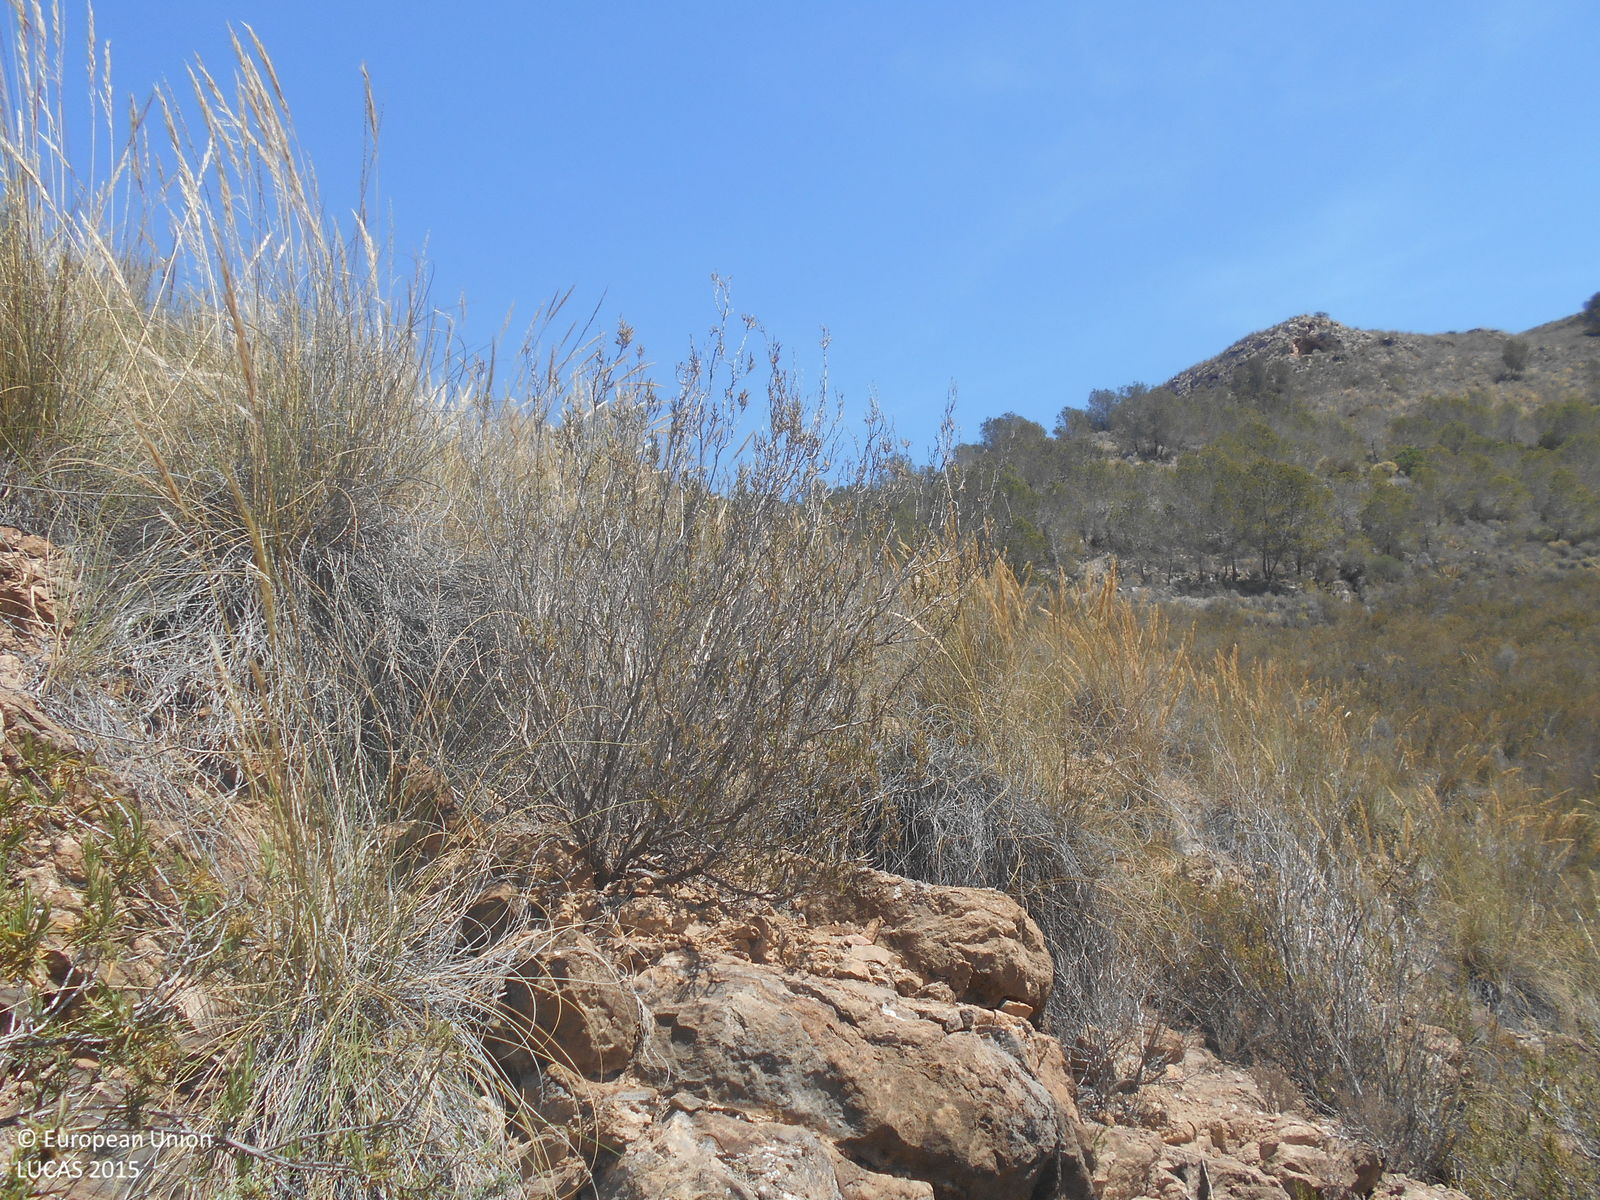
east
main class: Shrubland
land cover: Shrubland without tree cover
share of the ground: > 75 %
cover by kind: shrubs 90 %, unconsolidated bare surface 10 %
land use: Semi-natural and natural areas not in use
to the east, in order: Shrubland without tree cover; Tracks; Pine dominated coniferous woodland; Shrubland without tree cover
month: May
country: ES
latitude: 37.6387
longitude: -1.3014
